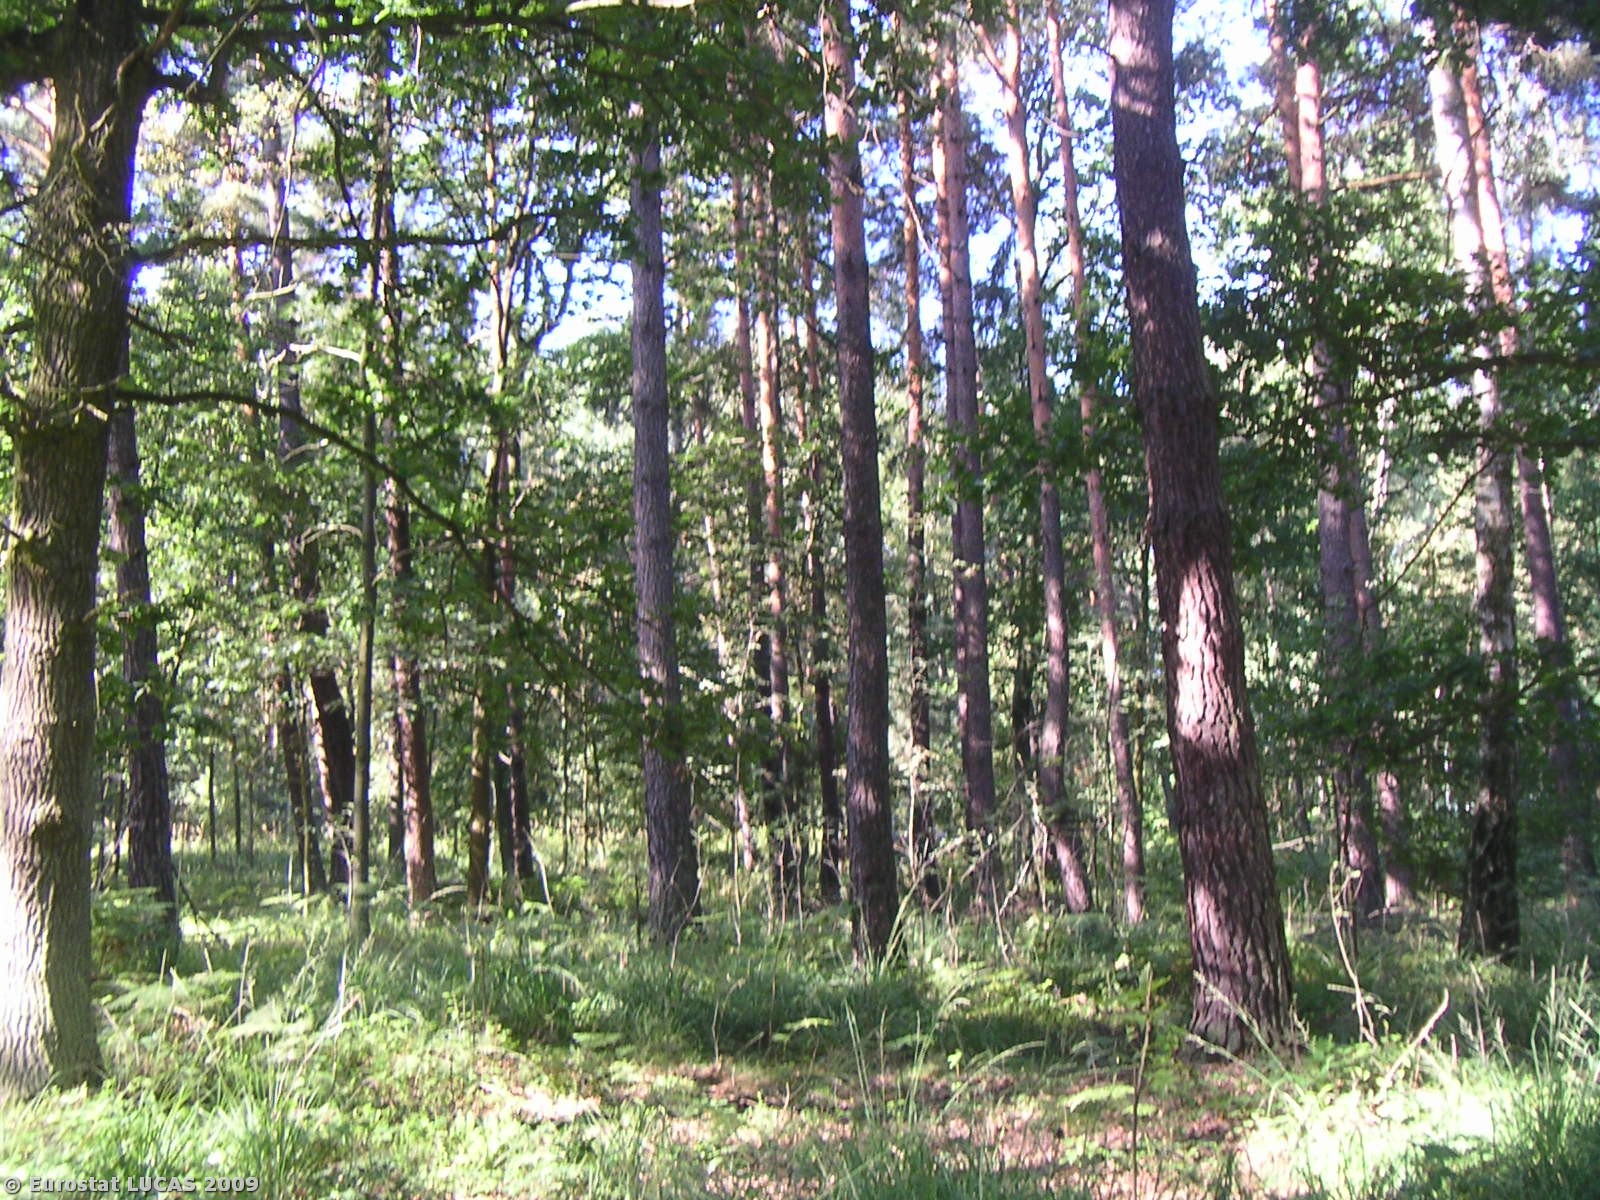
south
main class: Woodland
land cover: Mixed woodland
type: hemiboreal forest and nemoral coniferous forest and mixed broadleaved-coniferous forest
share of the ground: > 75 %
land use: Forestry
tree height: > 5 m
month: August
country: PL
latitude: 50.6527
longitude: 18.8622
